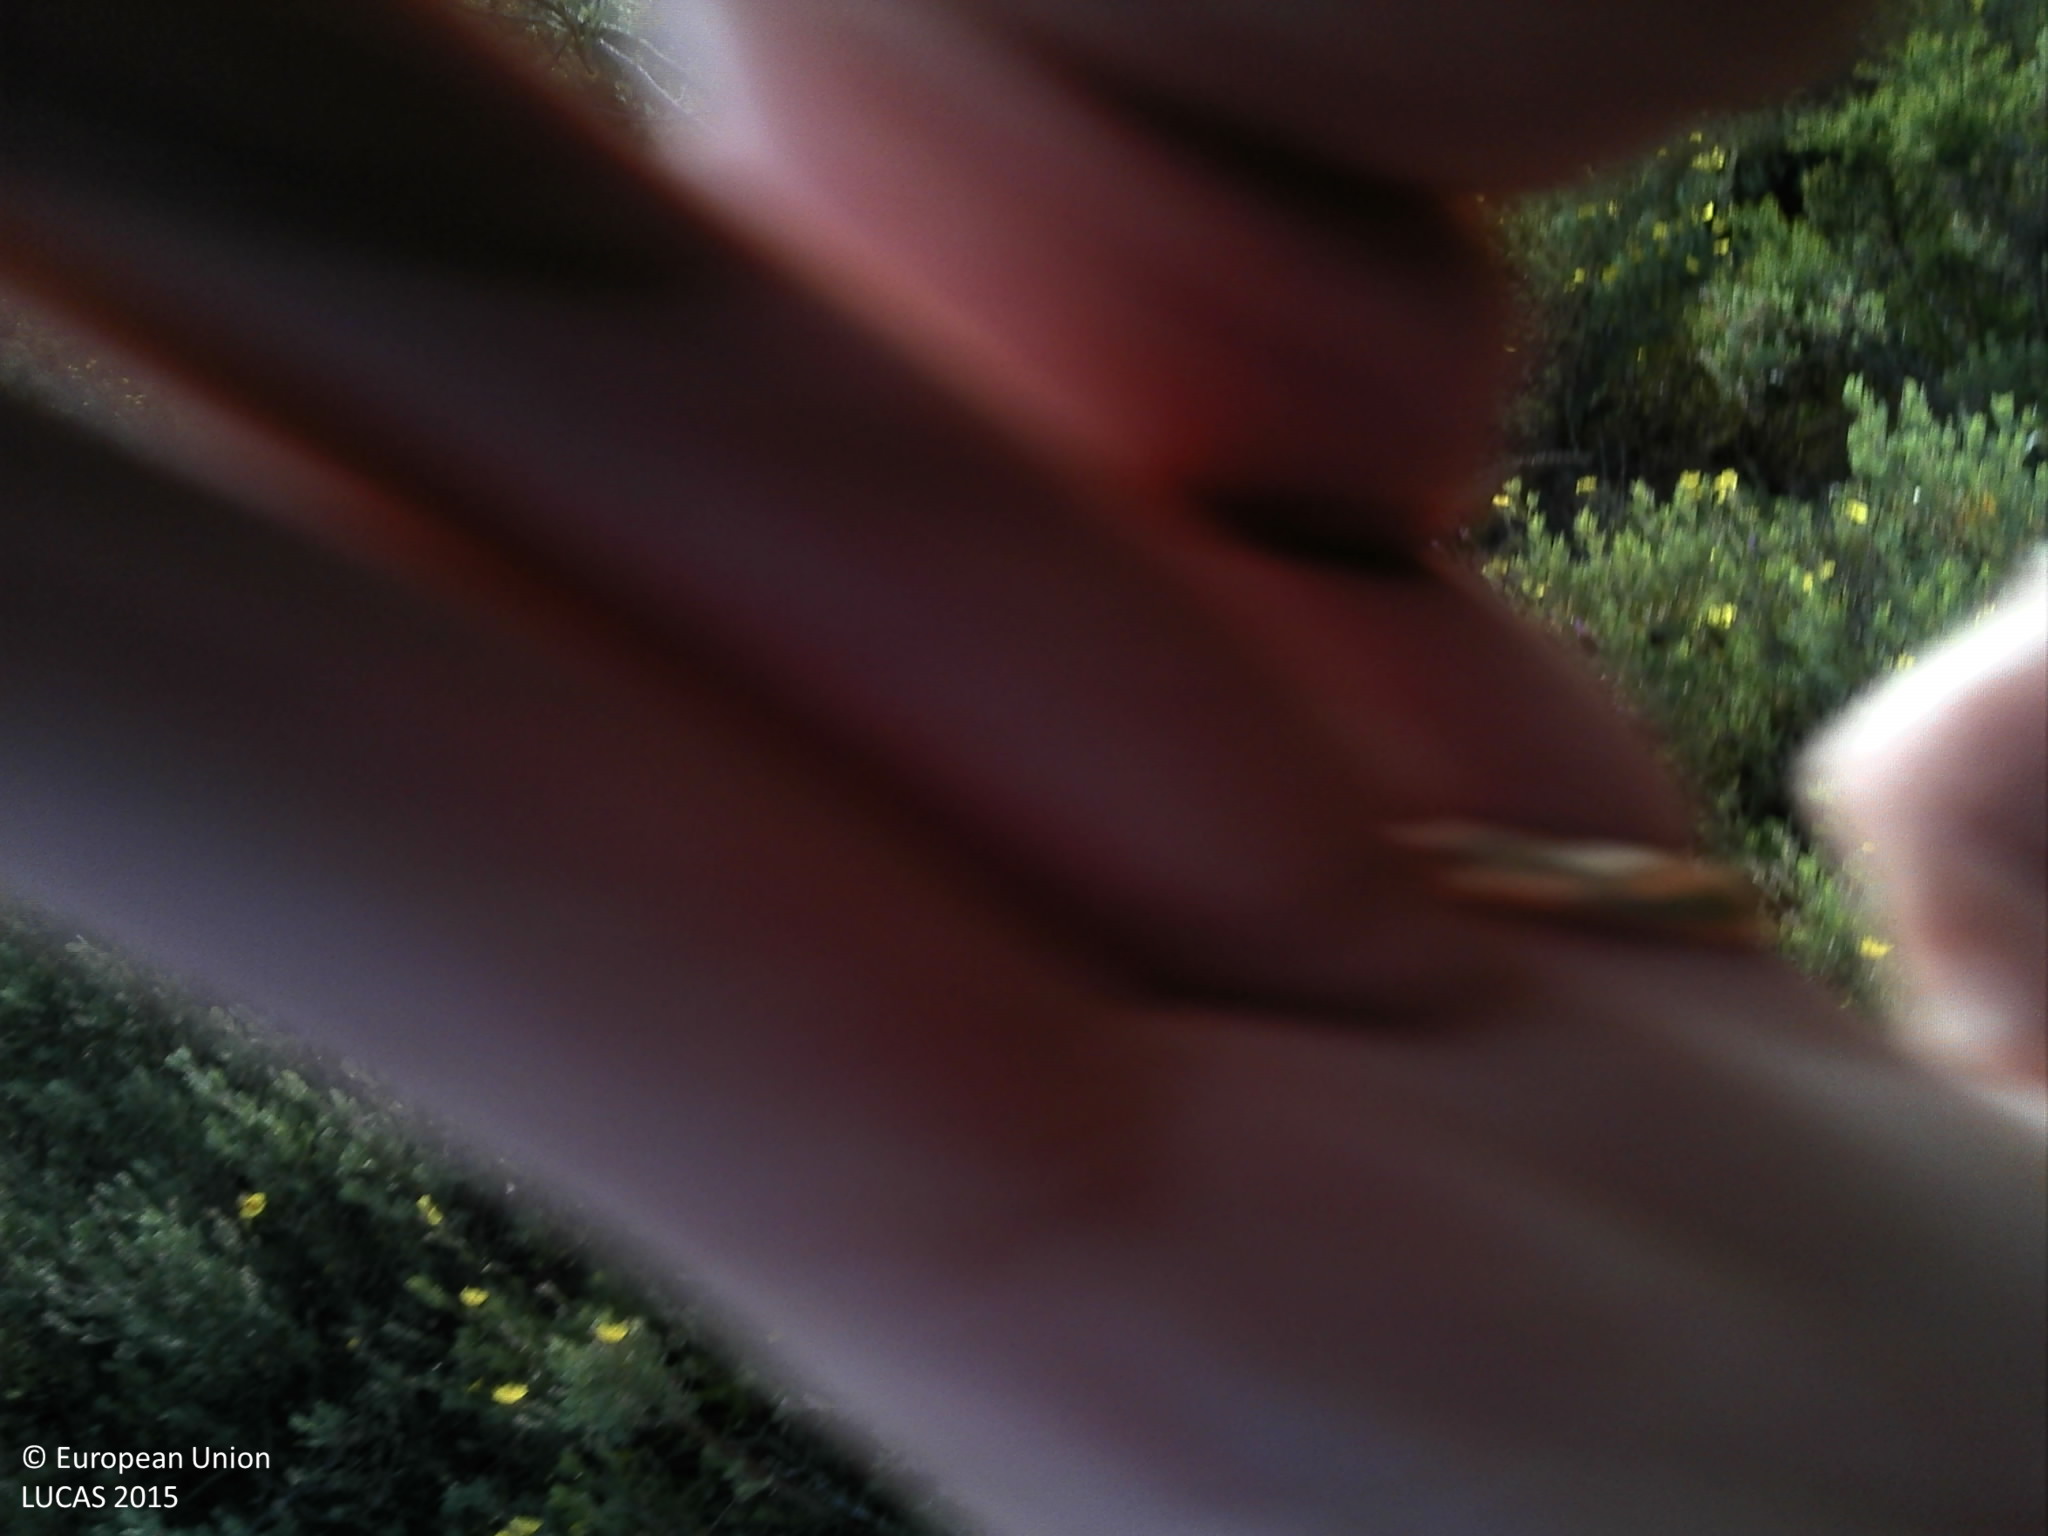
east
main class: Shrubland
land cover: Shrubland with sparse tree cover
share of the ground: 50 - 75 %
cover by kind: shrubs 60 %, herbaceous plants 25 %, consolidated bare surface 10 %, coniferous forest trees 5 %
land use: Semi-natural and natural areas not in use
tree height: < 5 m
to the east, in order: Shrubland with sparse tree cover
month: May
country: PT
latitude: 37.6351
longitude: -8.7974
